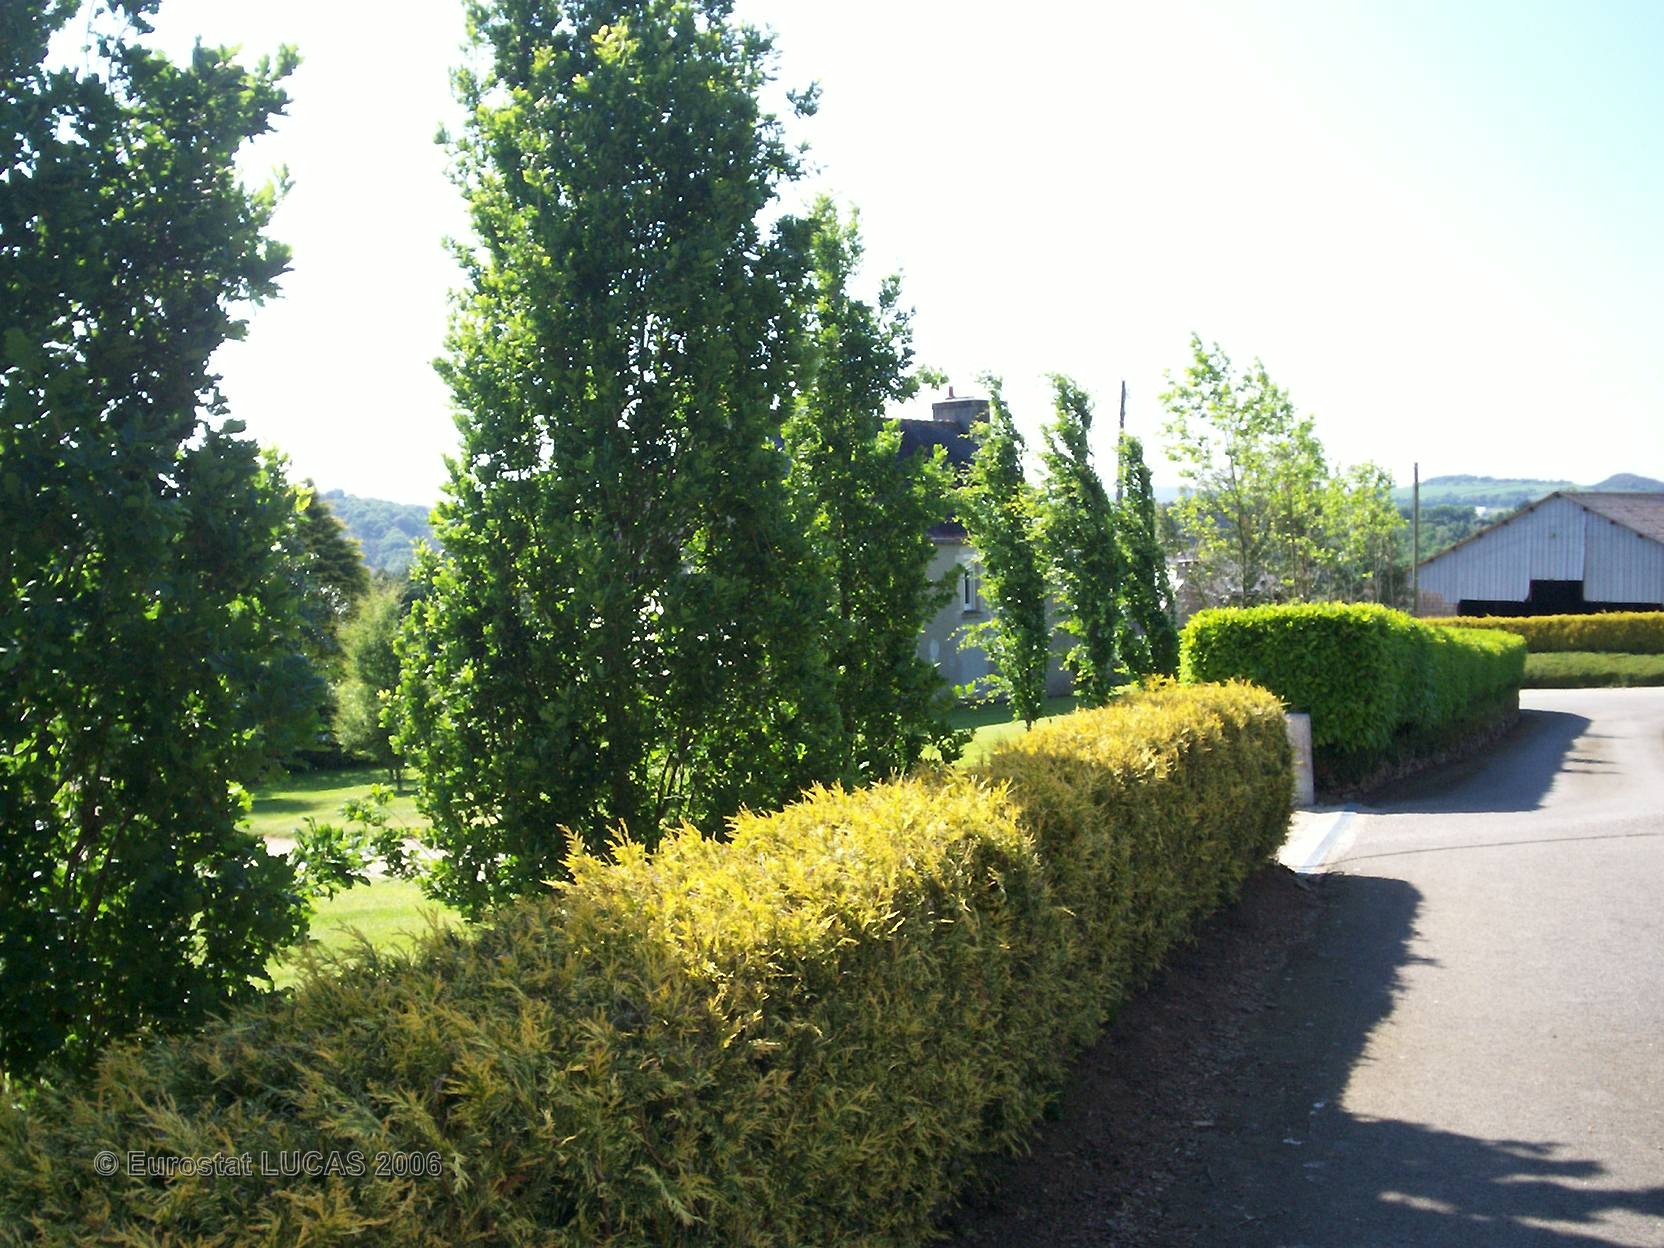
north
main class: Grassland
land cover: Grassland with sparse tree/shrub cover
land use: Residential
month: June
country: FR
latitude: 48.4229
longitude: -3.6900
